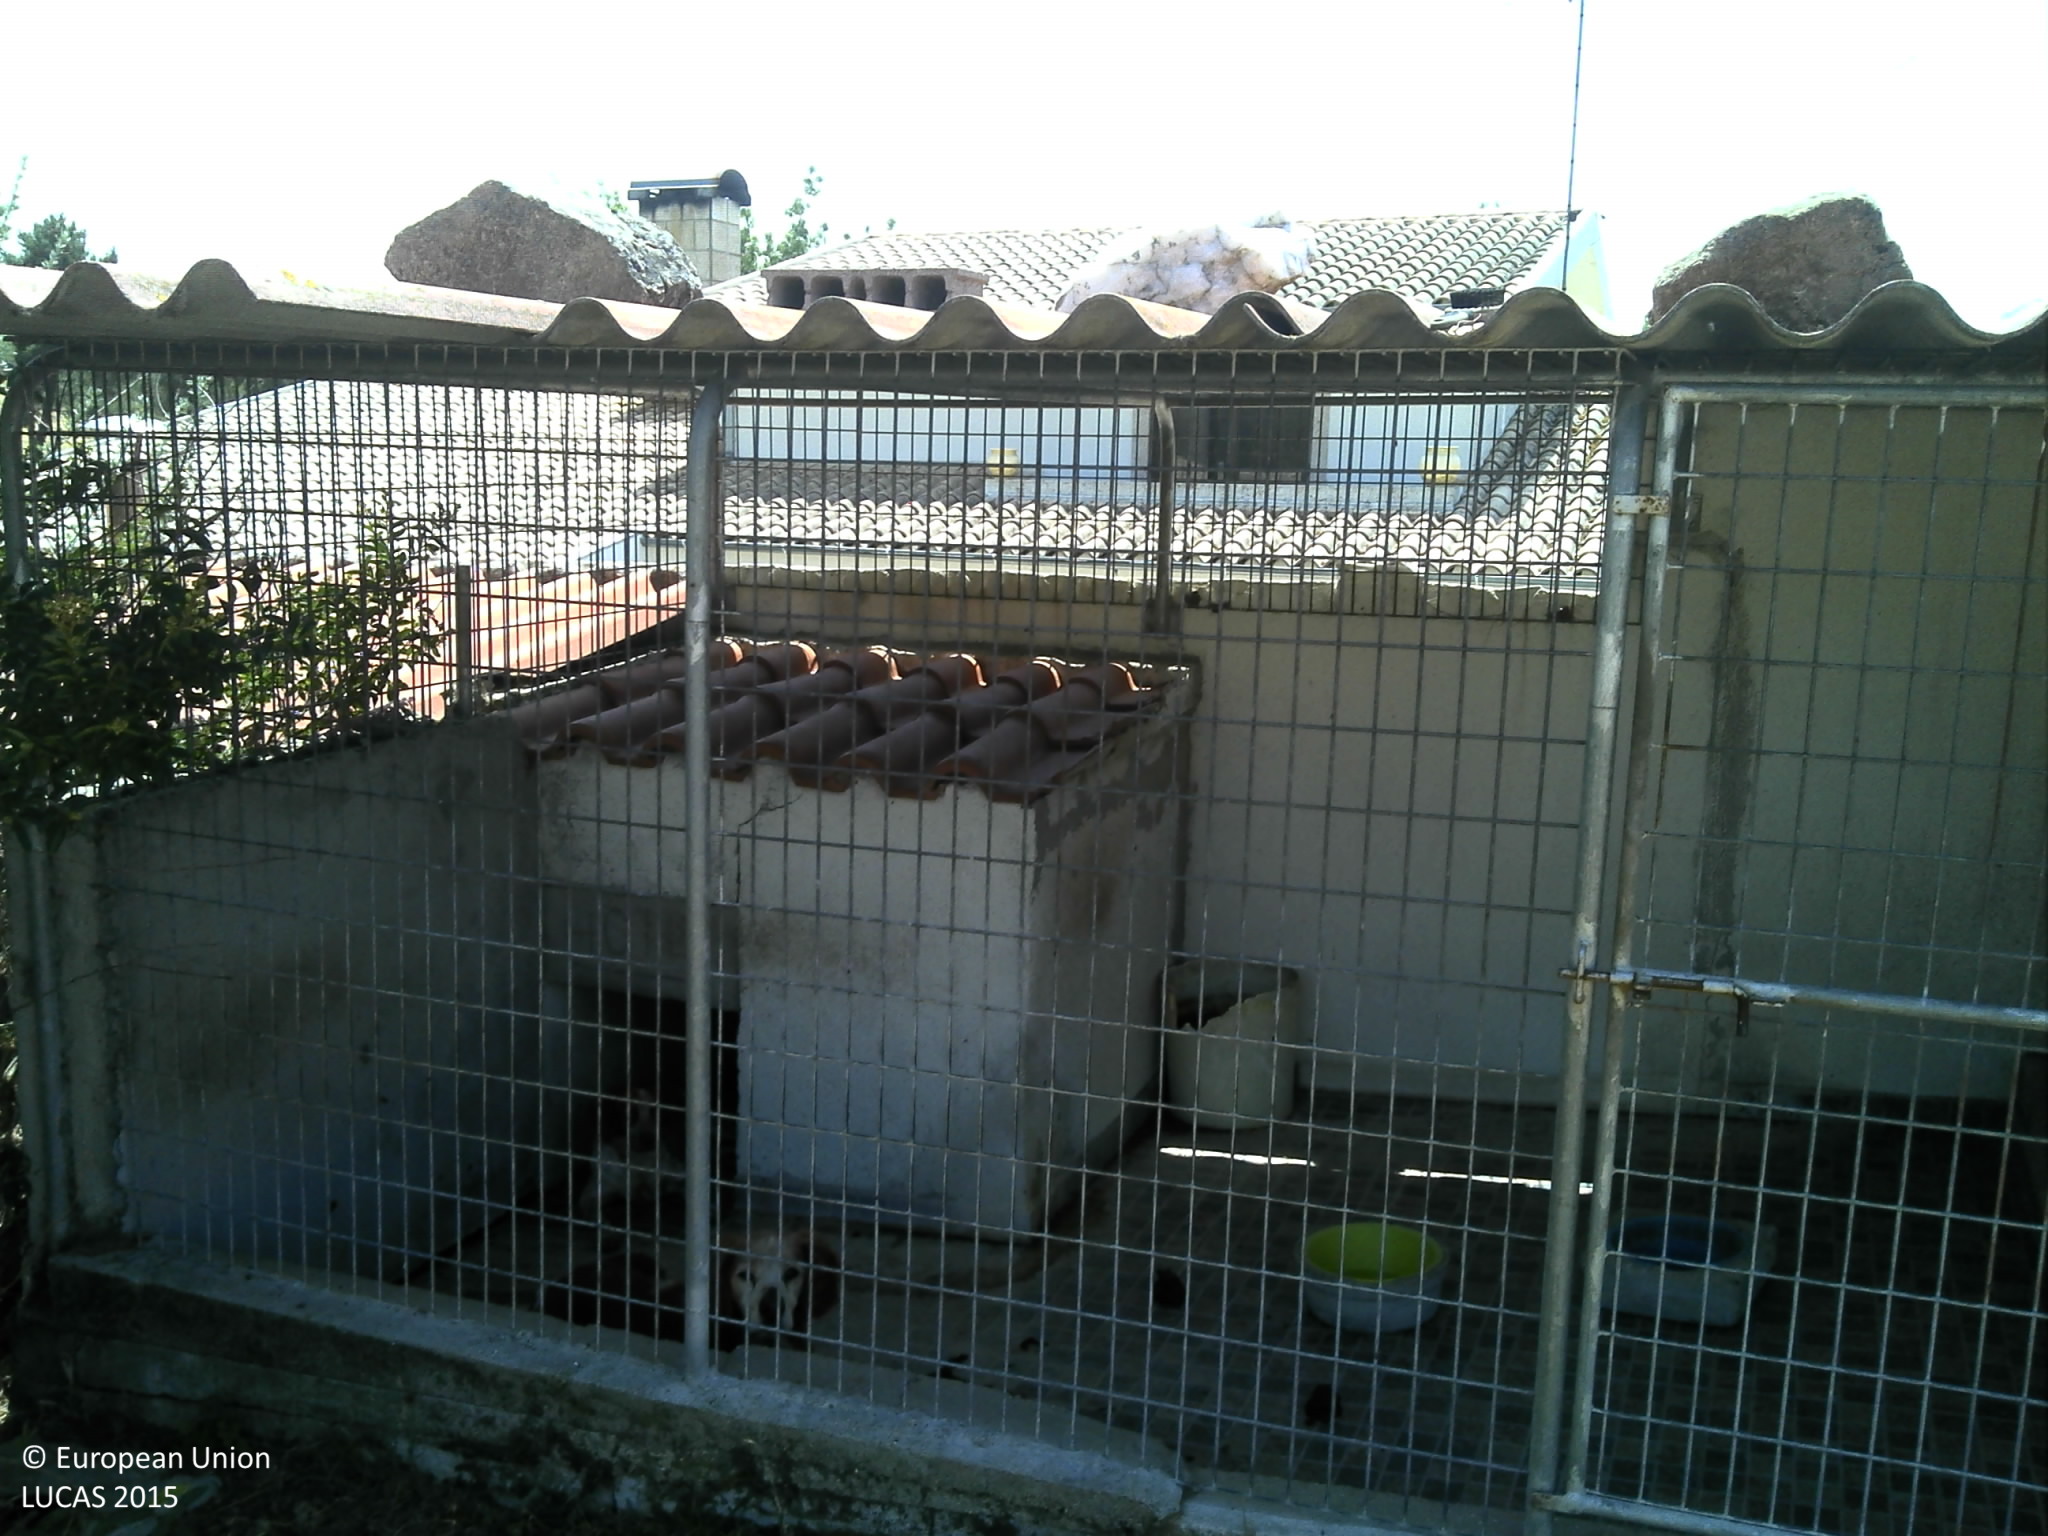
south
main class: Grassland
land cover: Grassland without tree/shrub cover
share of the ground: 50 - 75 %
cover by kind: herbaceous plants 50 %, unconsolidated bare surface 35 %, consolidated bare surface 10 %, shrubs 5 %
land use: Residential
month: July
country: PT
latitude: 40.8094
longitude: -7.3608
